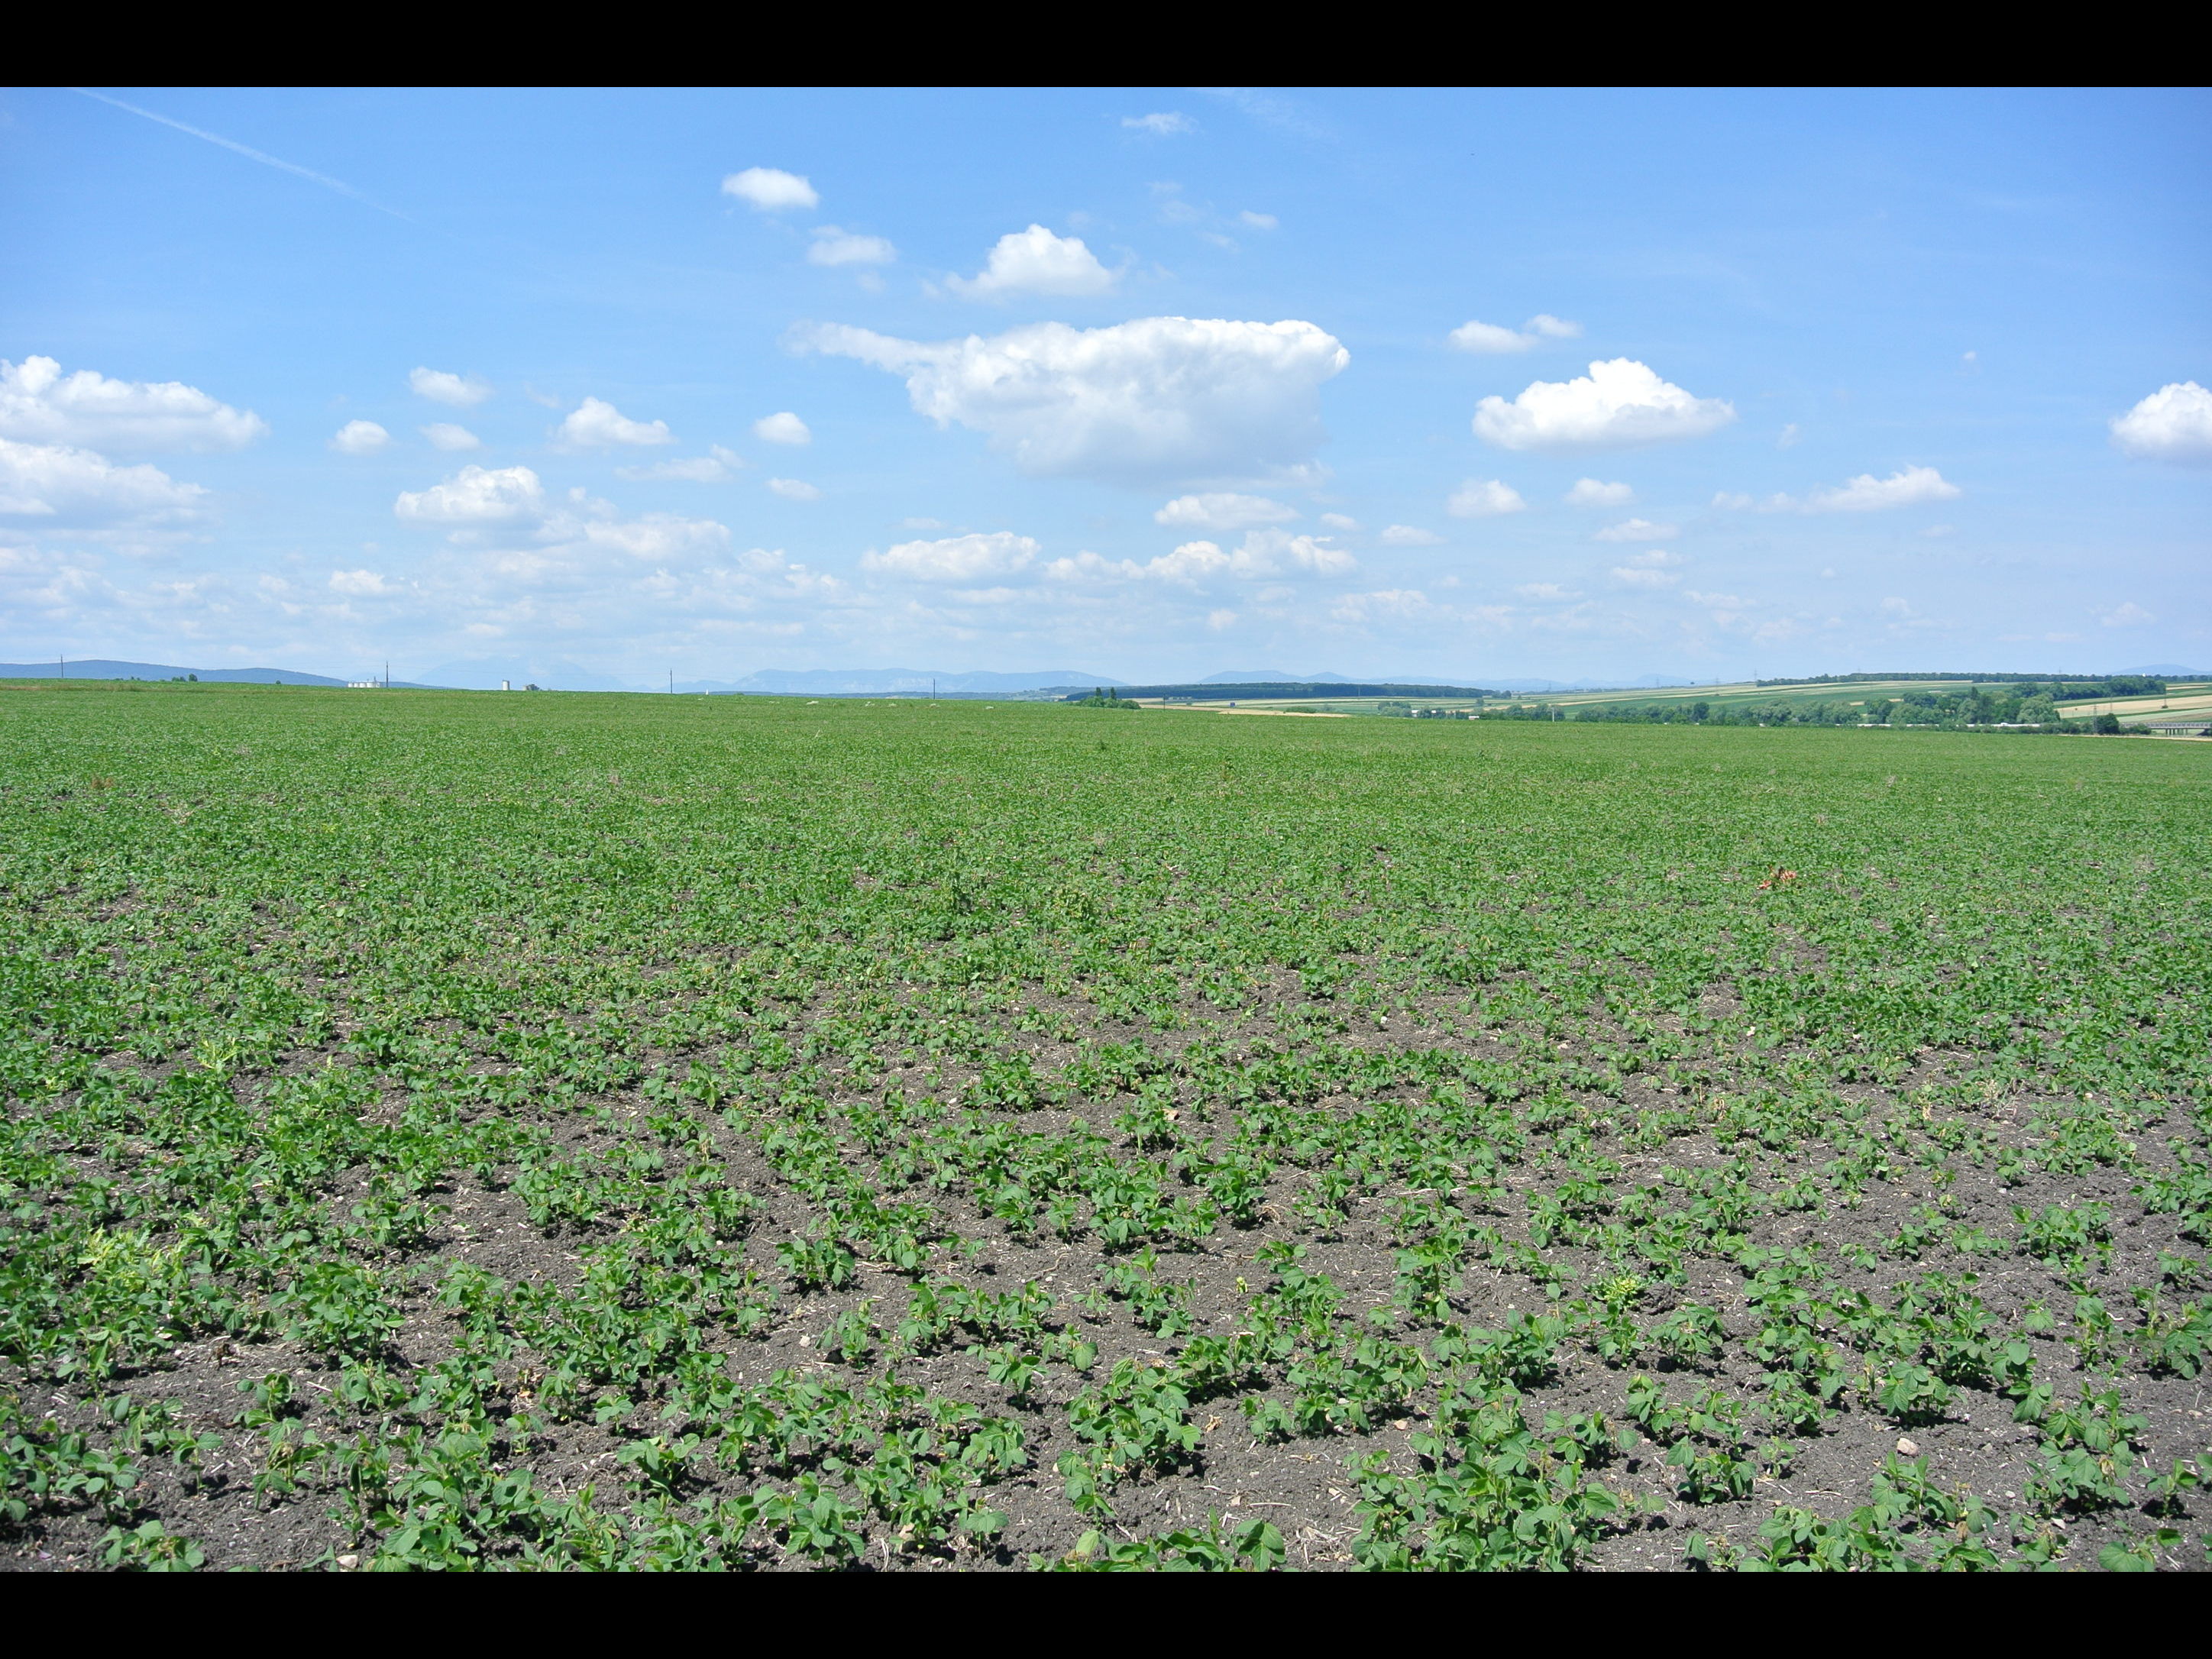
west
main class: Cropland
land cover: Soya
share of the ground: > 75 %
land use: Agriculture (excluding fallow land and kitchen gardens)
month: June
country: AT
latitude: 47.7818
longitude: 16.4507
